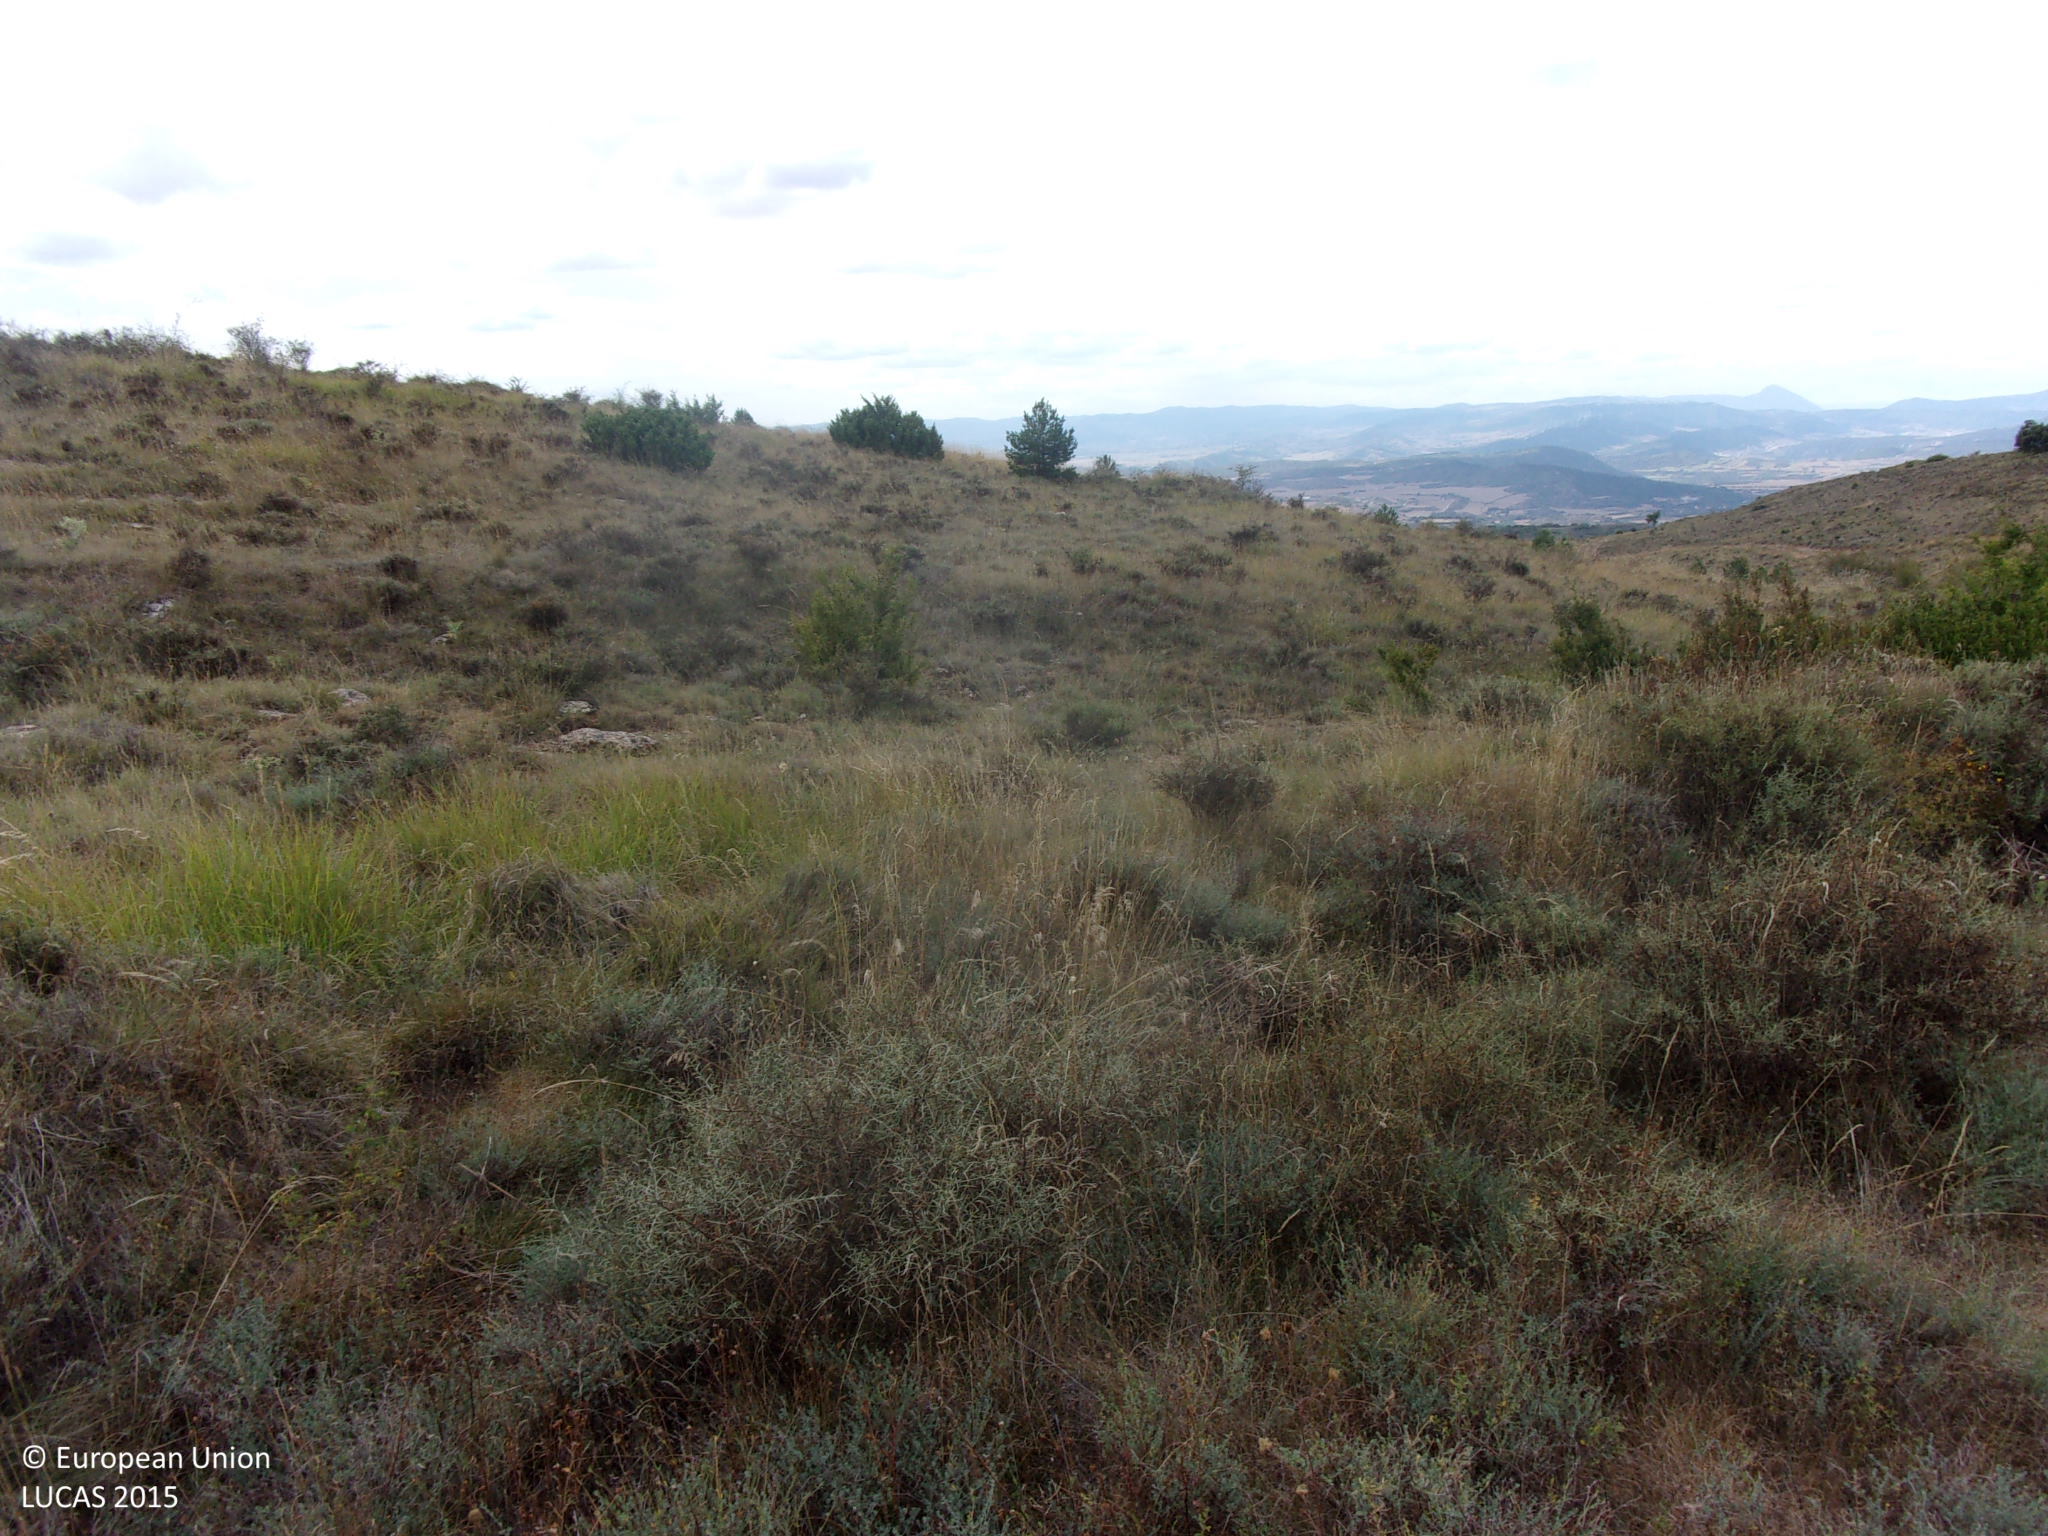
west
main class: Grassland
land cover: Grassland without tree/shrub cover
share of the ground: > 75 %
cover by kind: herbaceous plants 100 %
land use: Abandoned areas
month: August
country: ES
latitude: 42.5669
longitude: -1.1293
